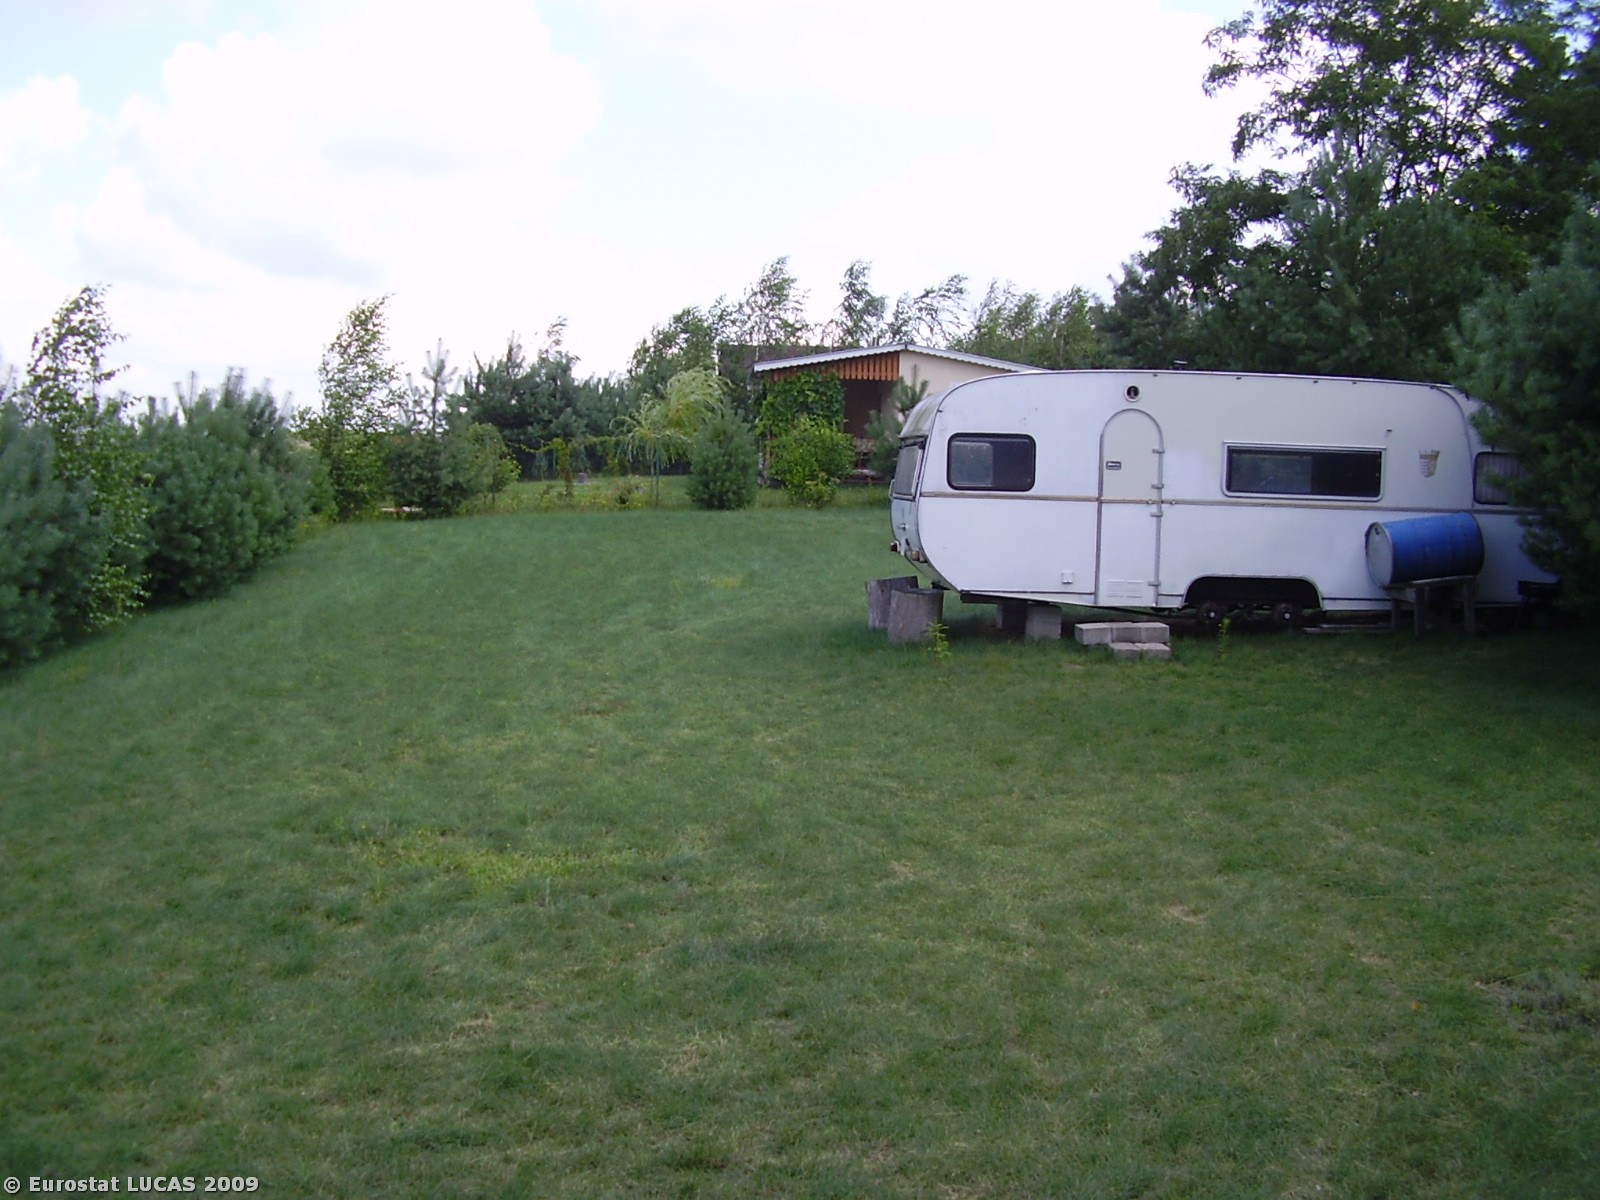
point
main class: Grassland
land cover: Grassland without tree/shrub cover
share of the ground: > 75 %
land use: Holiday camps
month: July
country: PL
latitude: 51.9394
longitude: 16.3054
